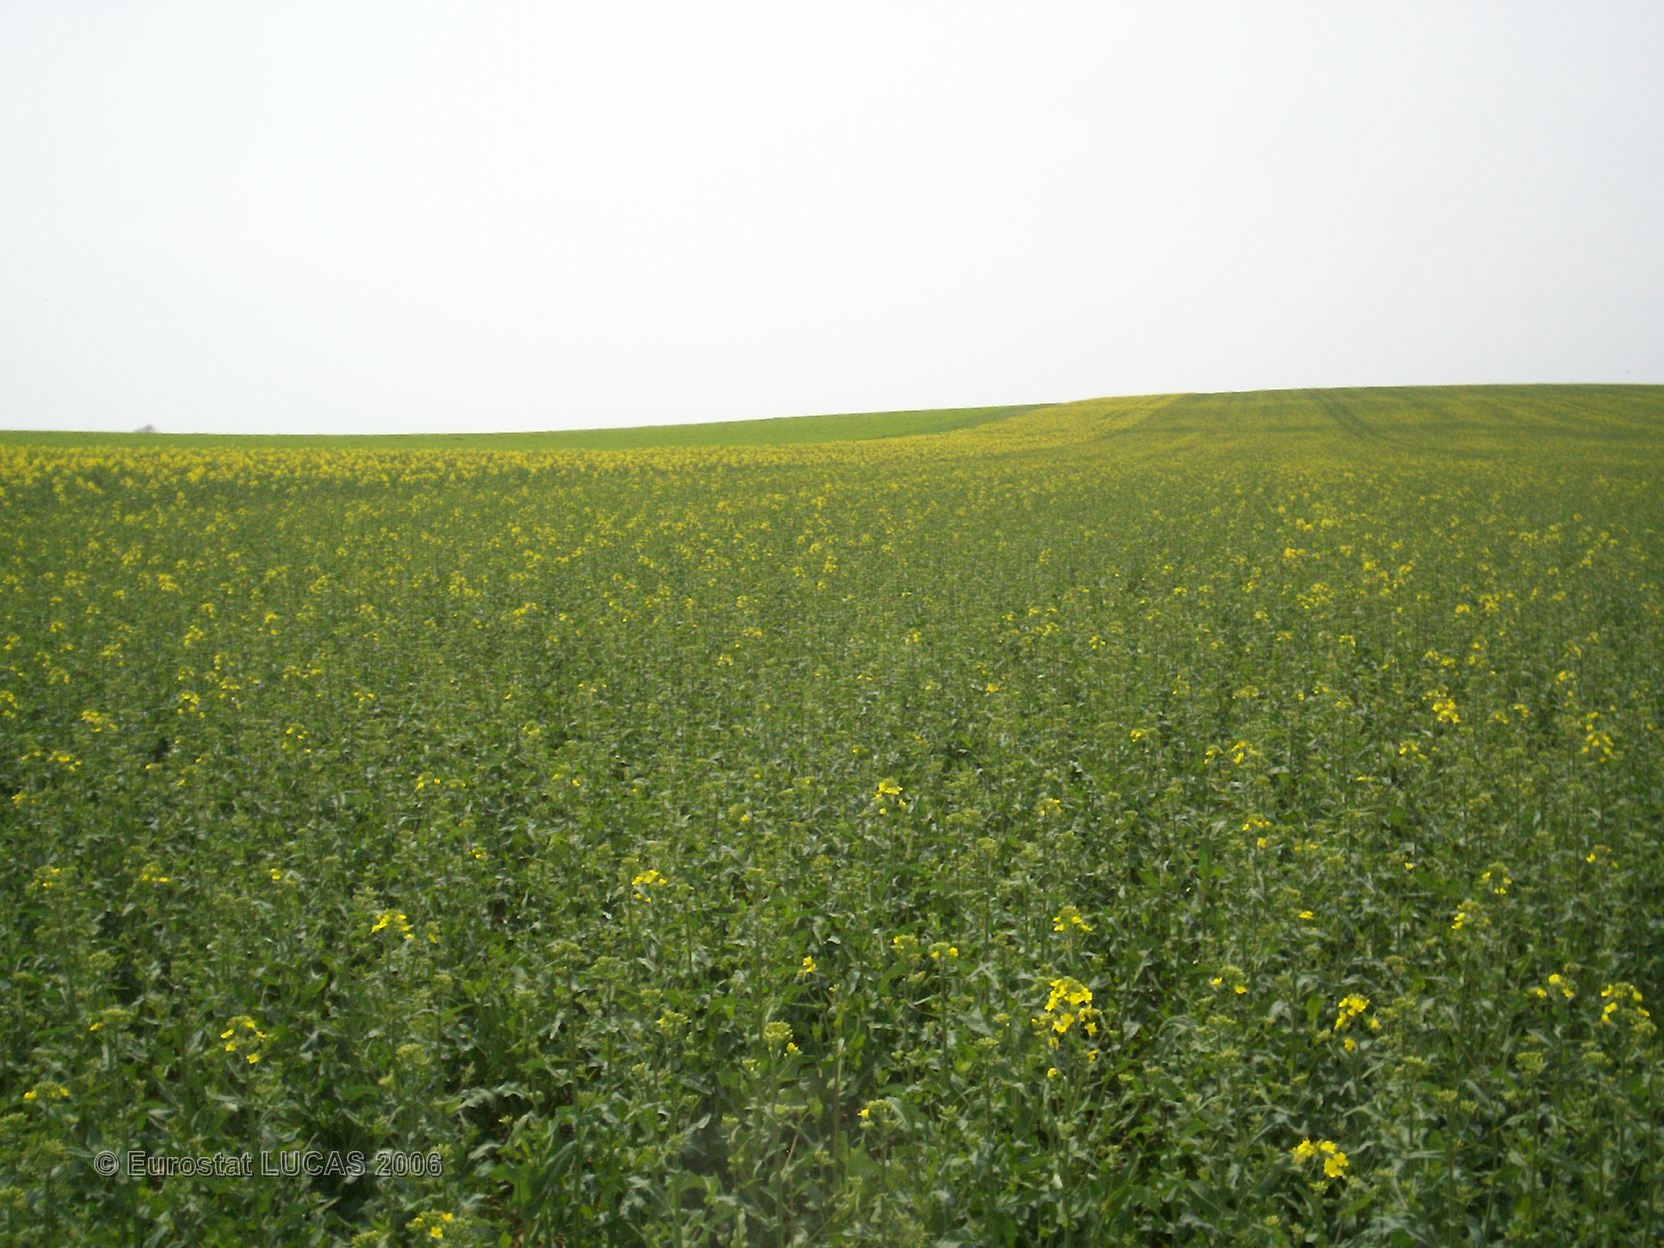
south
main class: Cropland
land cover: Rape and turnip rape
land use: Agriculture (excluding fallow land and kitchen gardens)
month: May
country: FR
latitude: 47.6215
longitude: 4.5835
